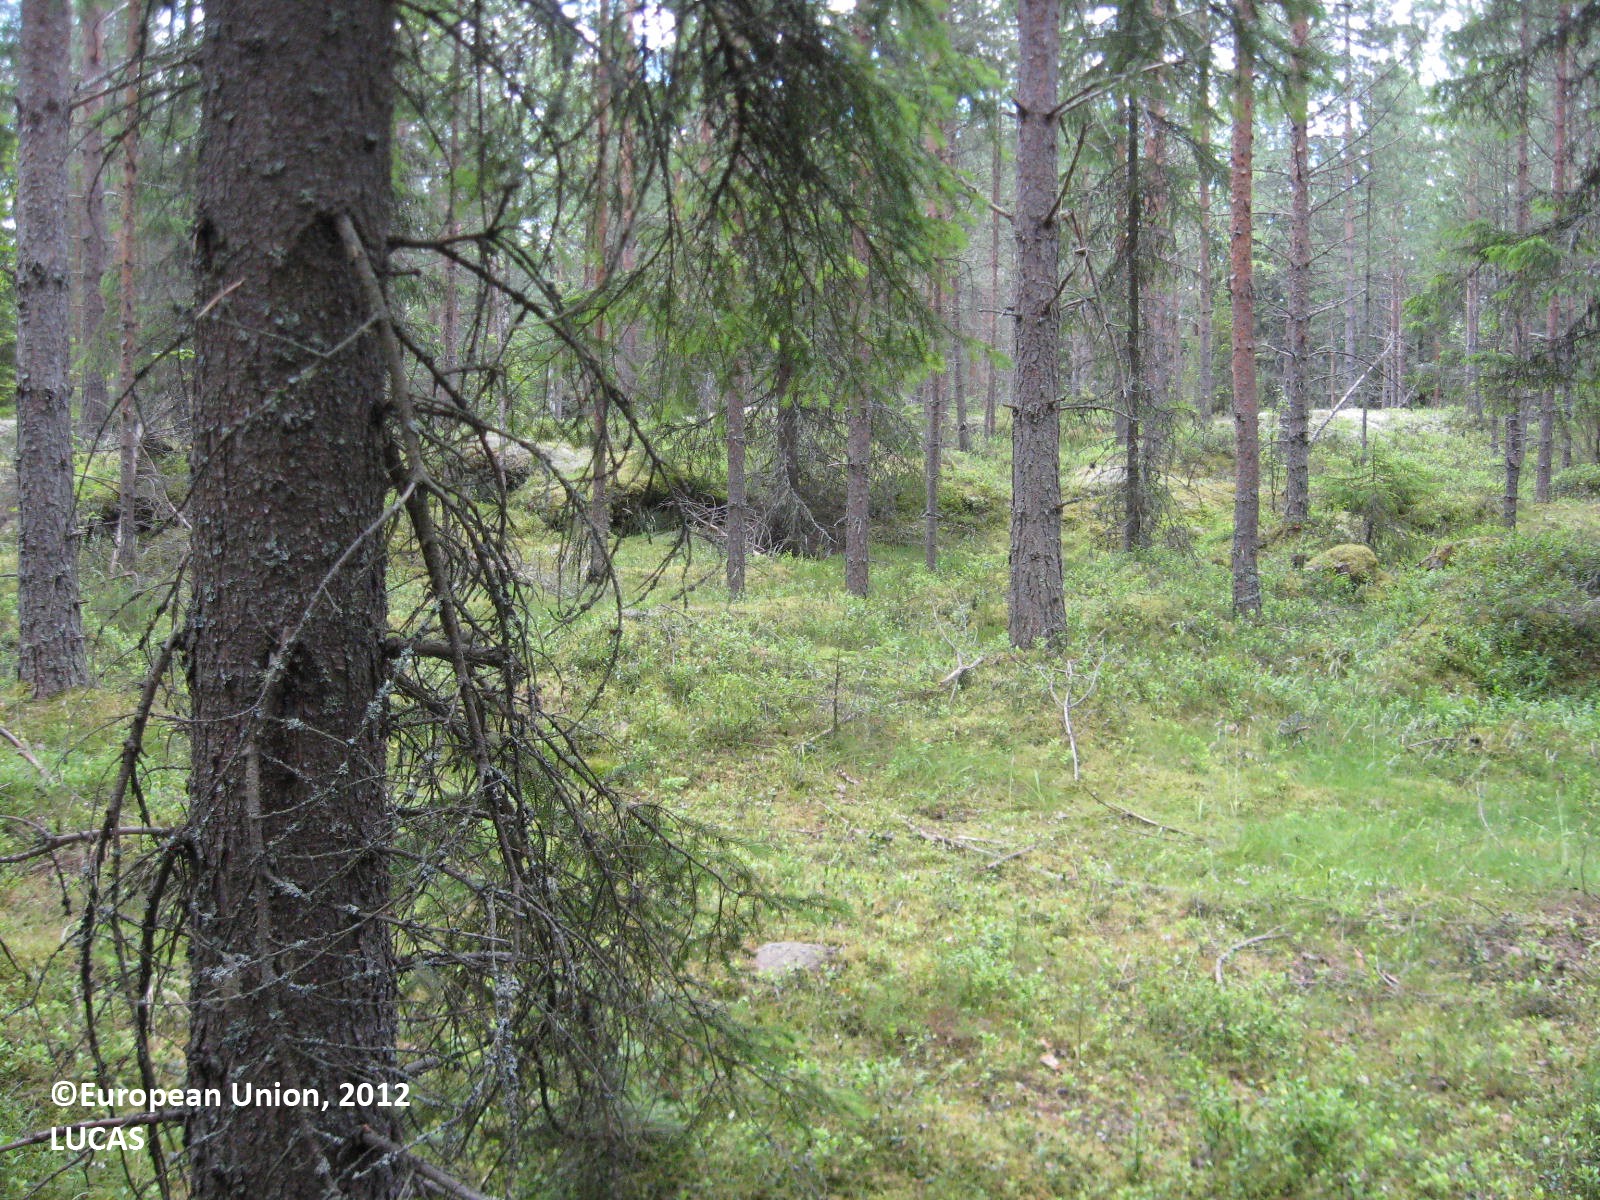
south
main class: Woodland
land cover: Other coniferous woodland
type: boreal forest
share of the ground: > 75 %
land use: Forestry
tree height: > 5 m
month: July
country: FI
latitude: 62.6576
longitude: 22.4856
